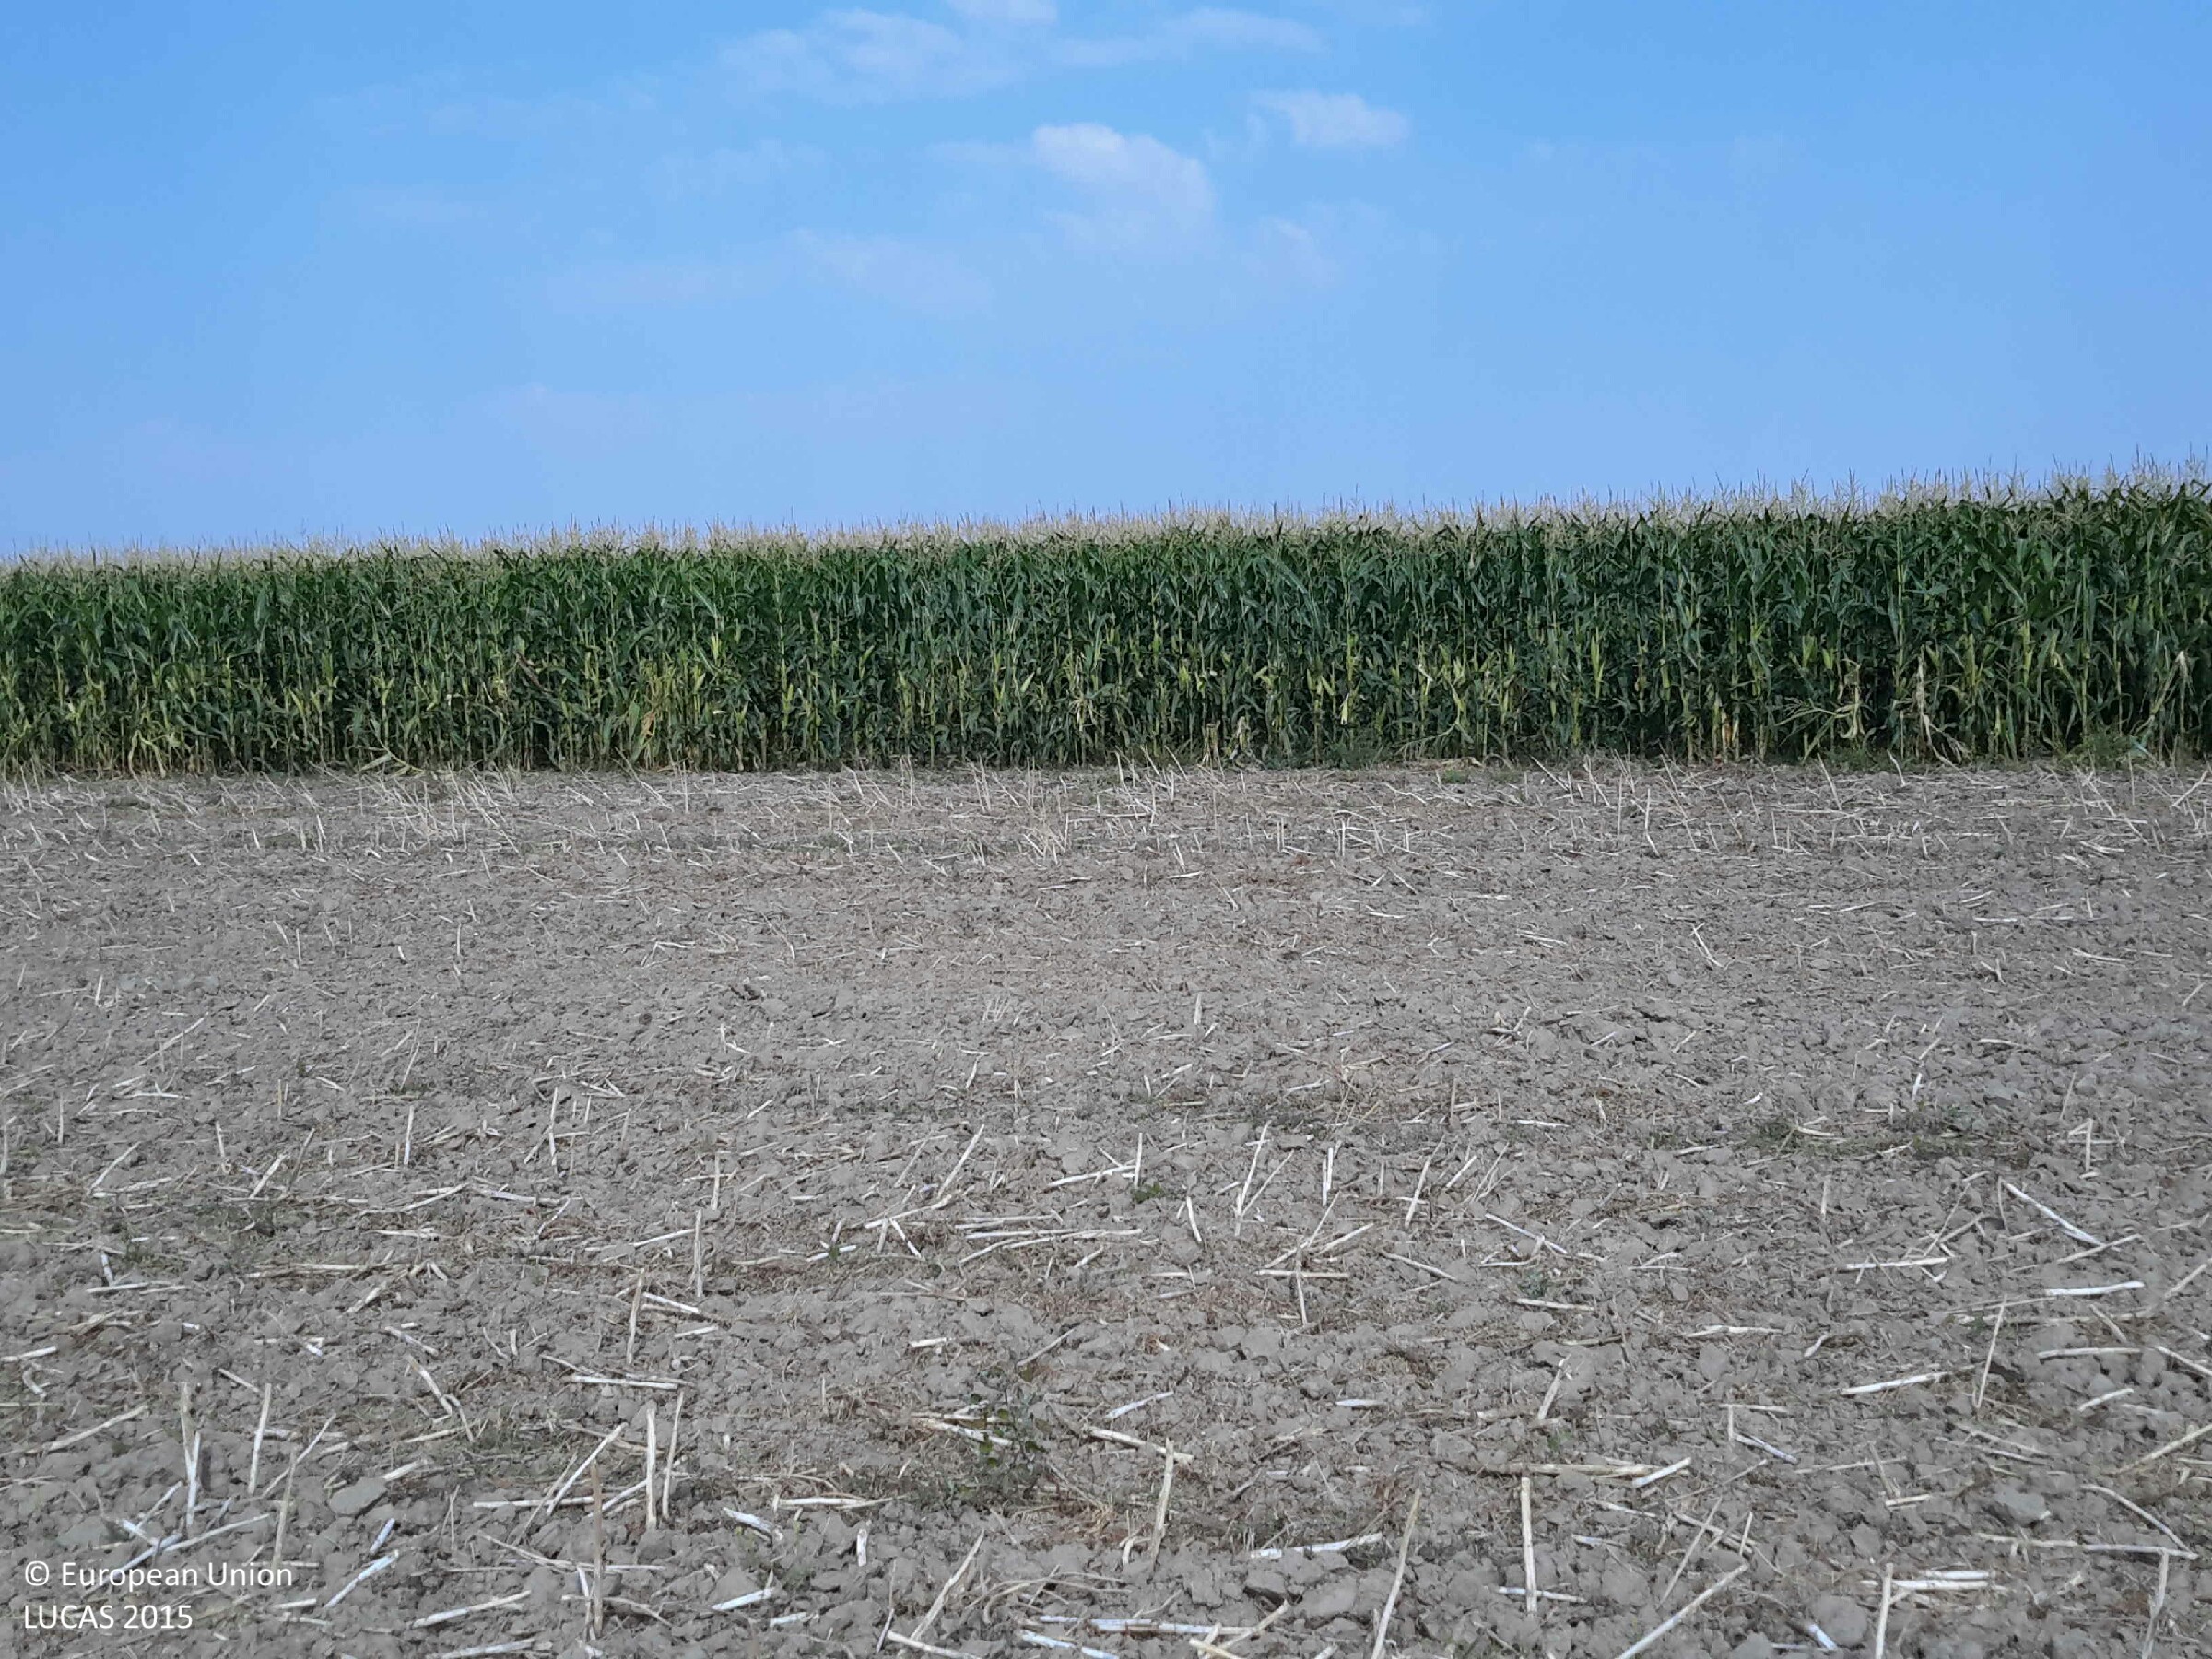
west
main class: Cropland
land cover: Soya
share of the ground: 50 - 75 %
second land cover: Spontaneously vegetated surfaces
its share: 50 - 75 %
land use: Agriculture (excluding fallow land and kitchen gardens)
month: August
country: HU
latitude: 47.8501
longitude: 17.3720
